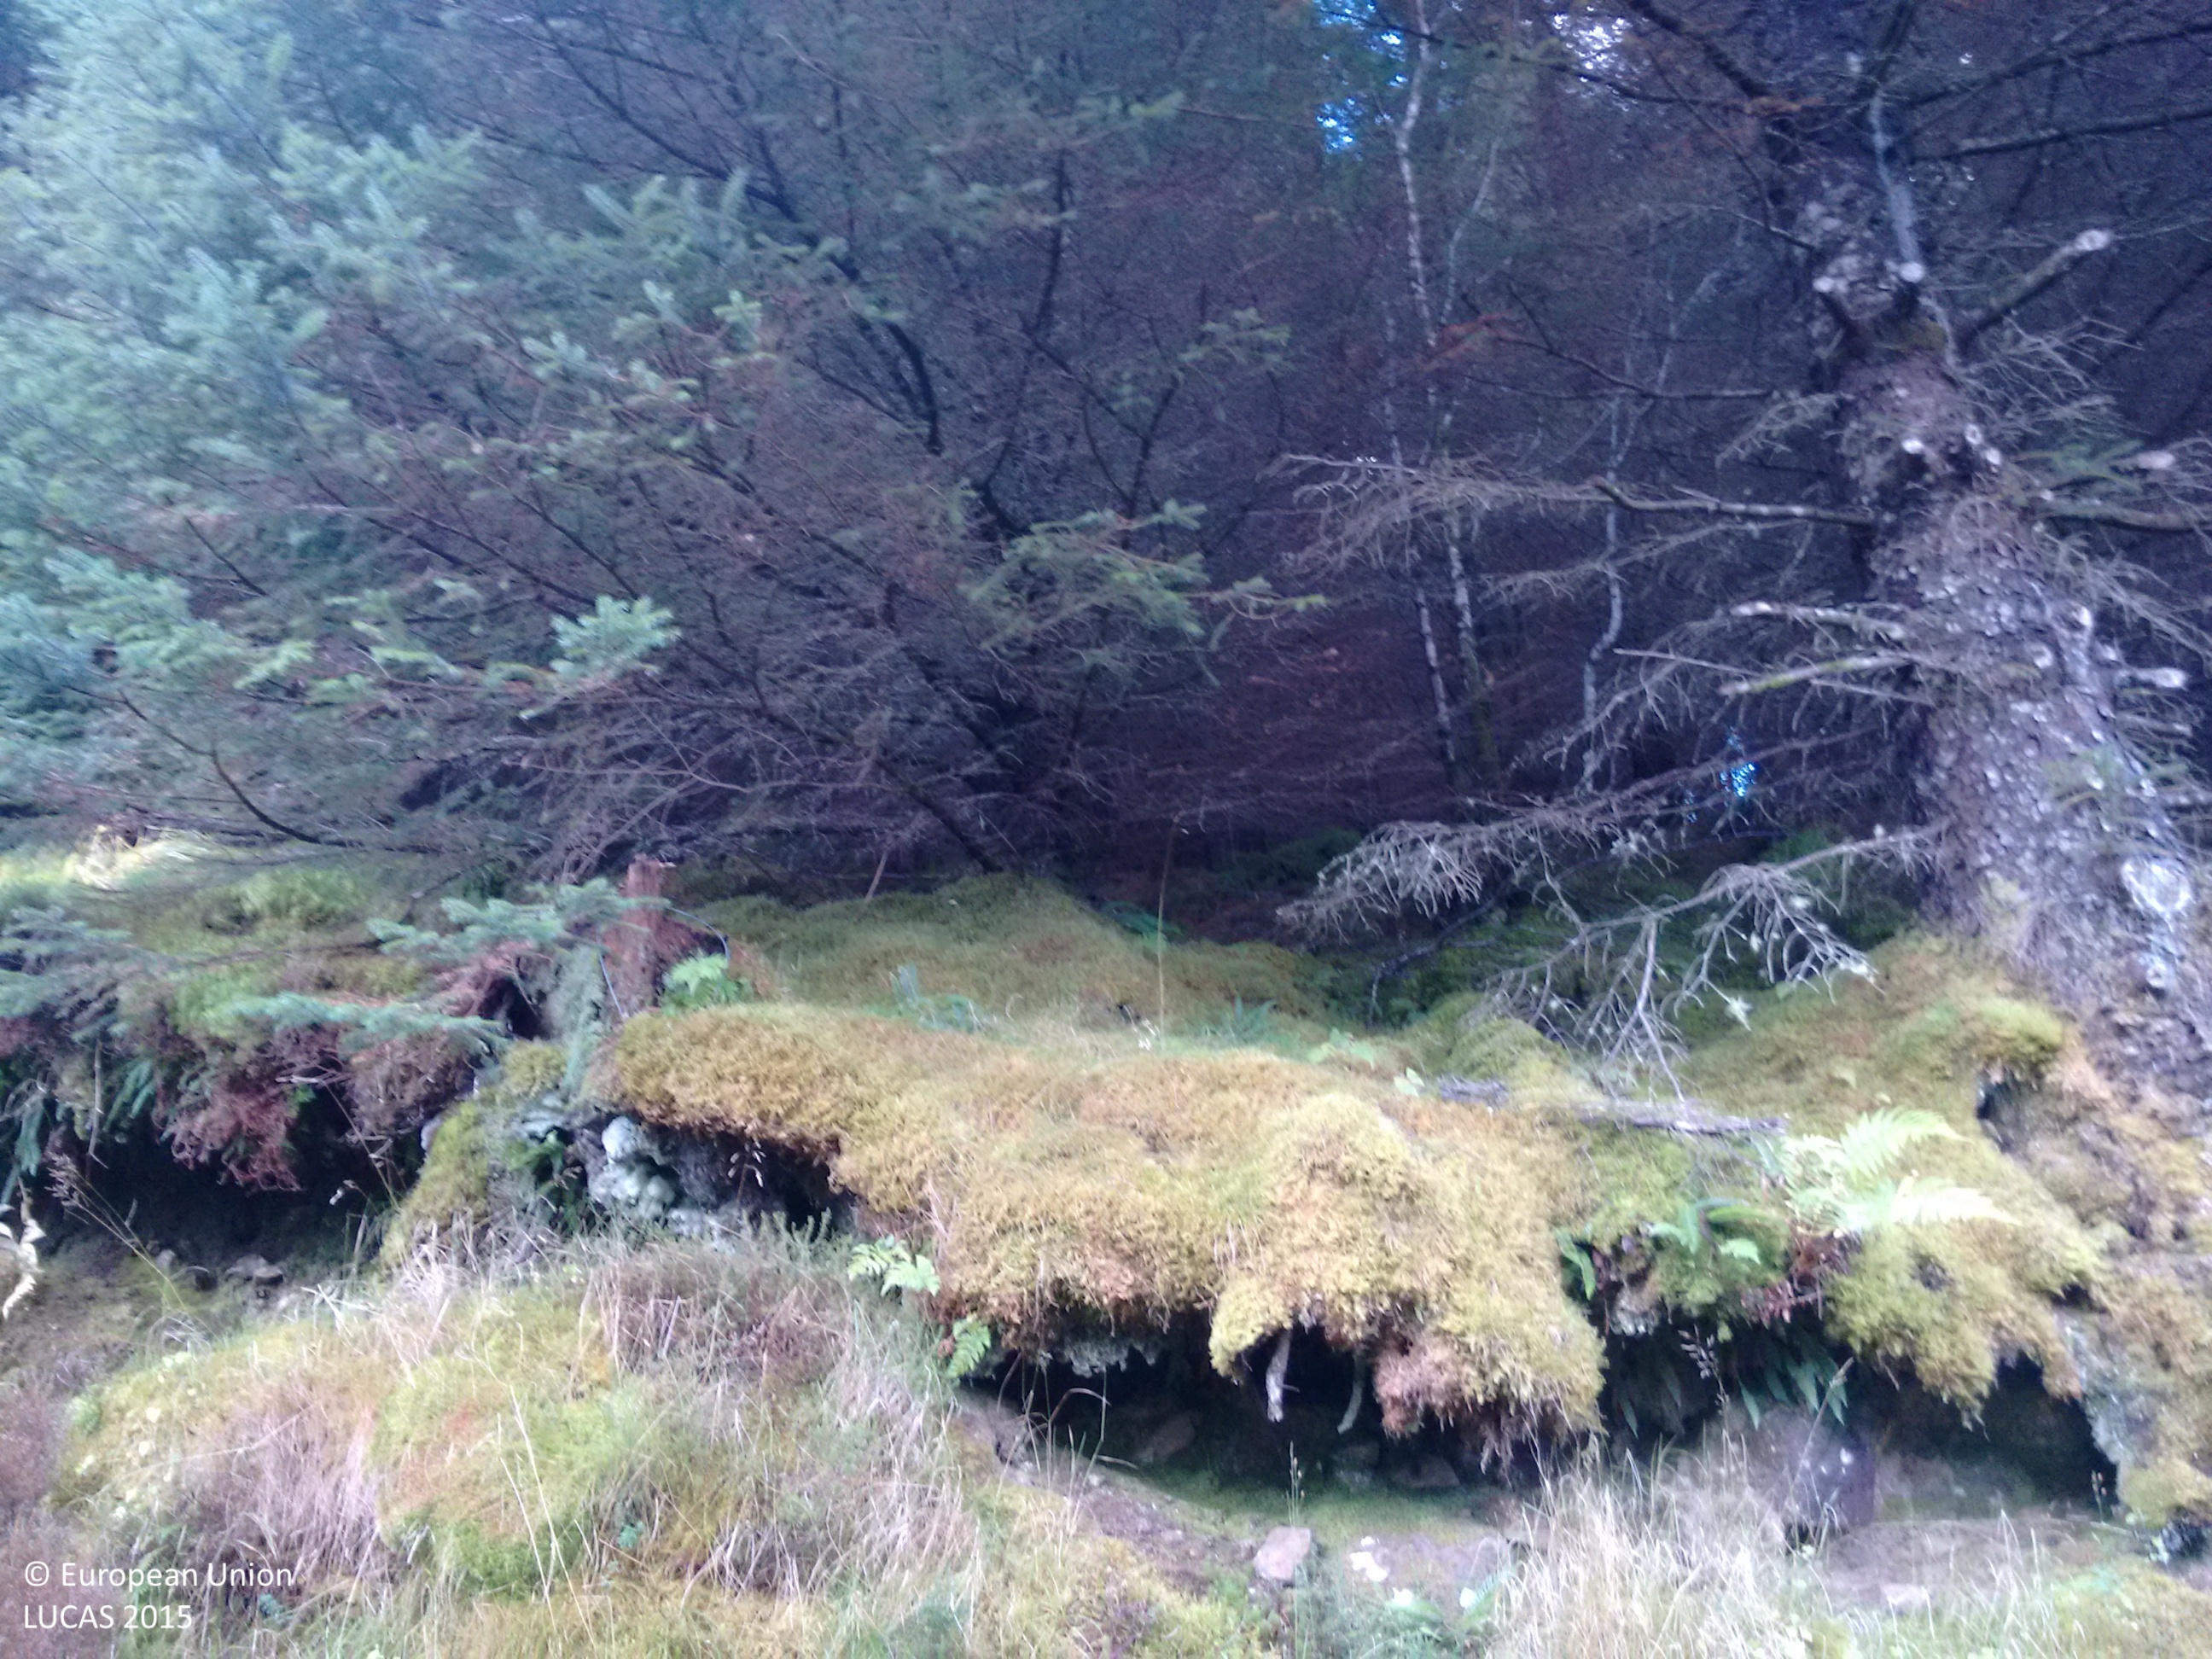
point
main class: Woodland
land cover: Spruce dominated coniferous woodland
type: exotic forest
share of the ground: > 75 %
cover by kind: coniferous forest trees 100 %
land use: Forestry
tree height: > 5 m
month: October
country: GB
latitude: 56.5808
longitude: -5.7720
